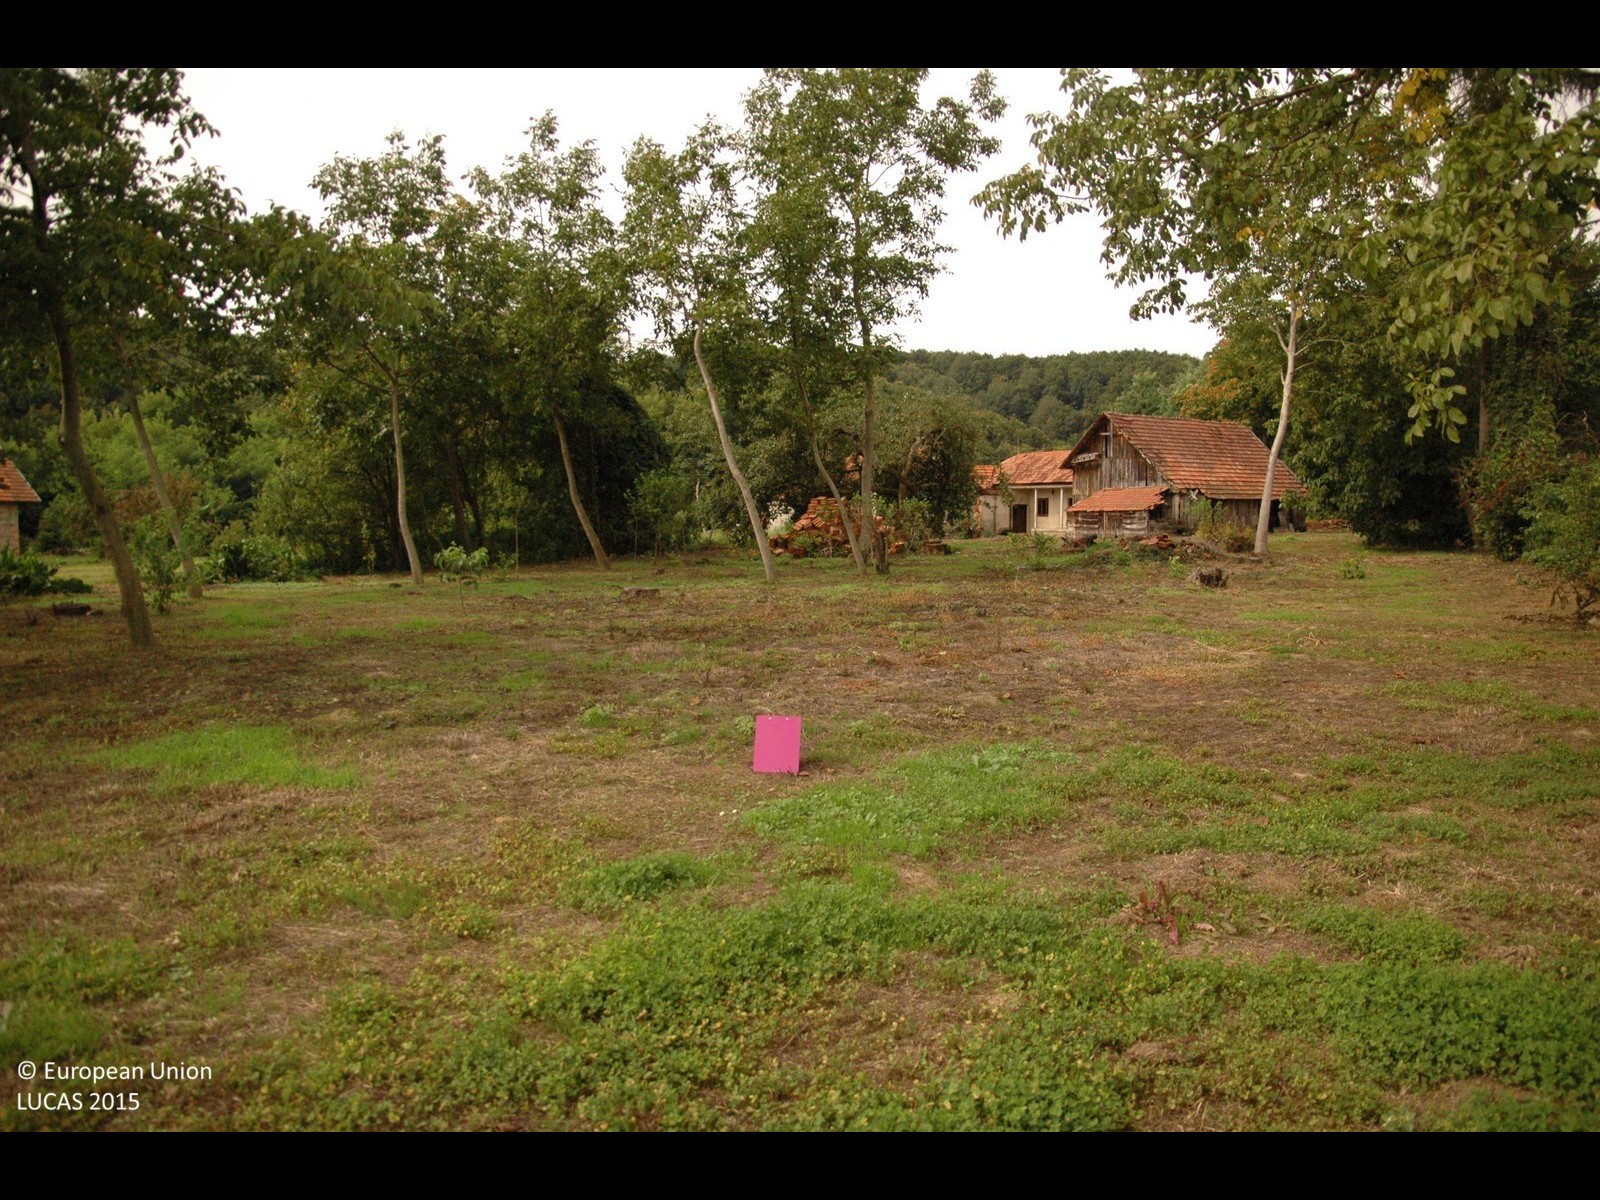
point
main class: Grassland
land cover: Grassland with sparse tree/shrub cover
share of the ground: > 75 %
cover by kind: herbaceous plants 95 %, broadleaved forest trees 5 %
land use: Agriculture (excluding fallow land and kitchen gardens)
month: September
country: HR
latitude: 46.0729
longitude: 16.9185
